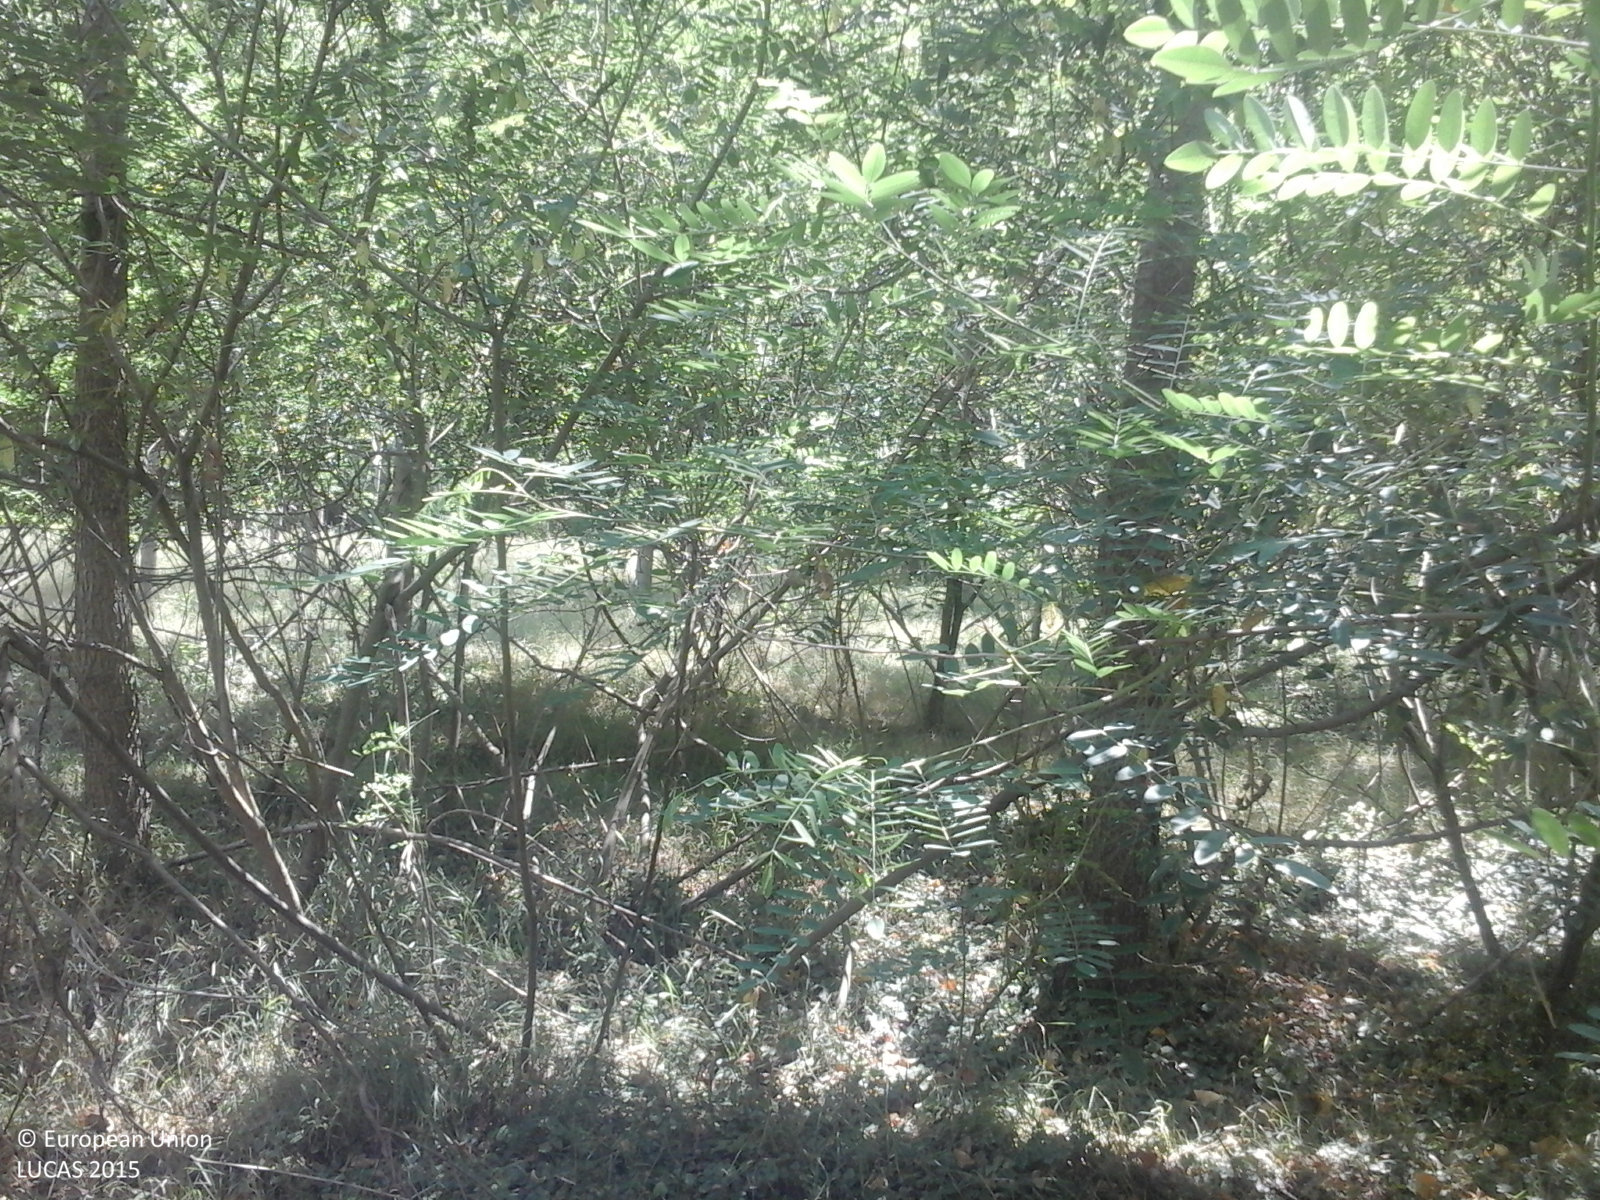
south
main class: Woodland
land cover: Broadleaved woodland
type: floodplain forest
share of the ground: > 75 %
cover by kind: broadleaved forest trees 80 %, herbaceous plants 20 %
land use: Forestry
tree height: > 5 m
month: July
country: RO
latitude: 44.1294
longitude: 27.4470
